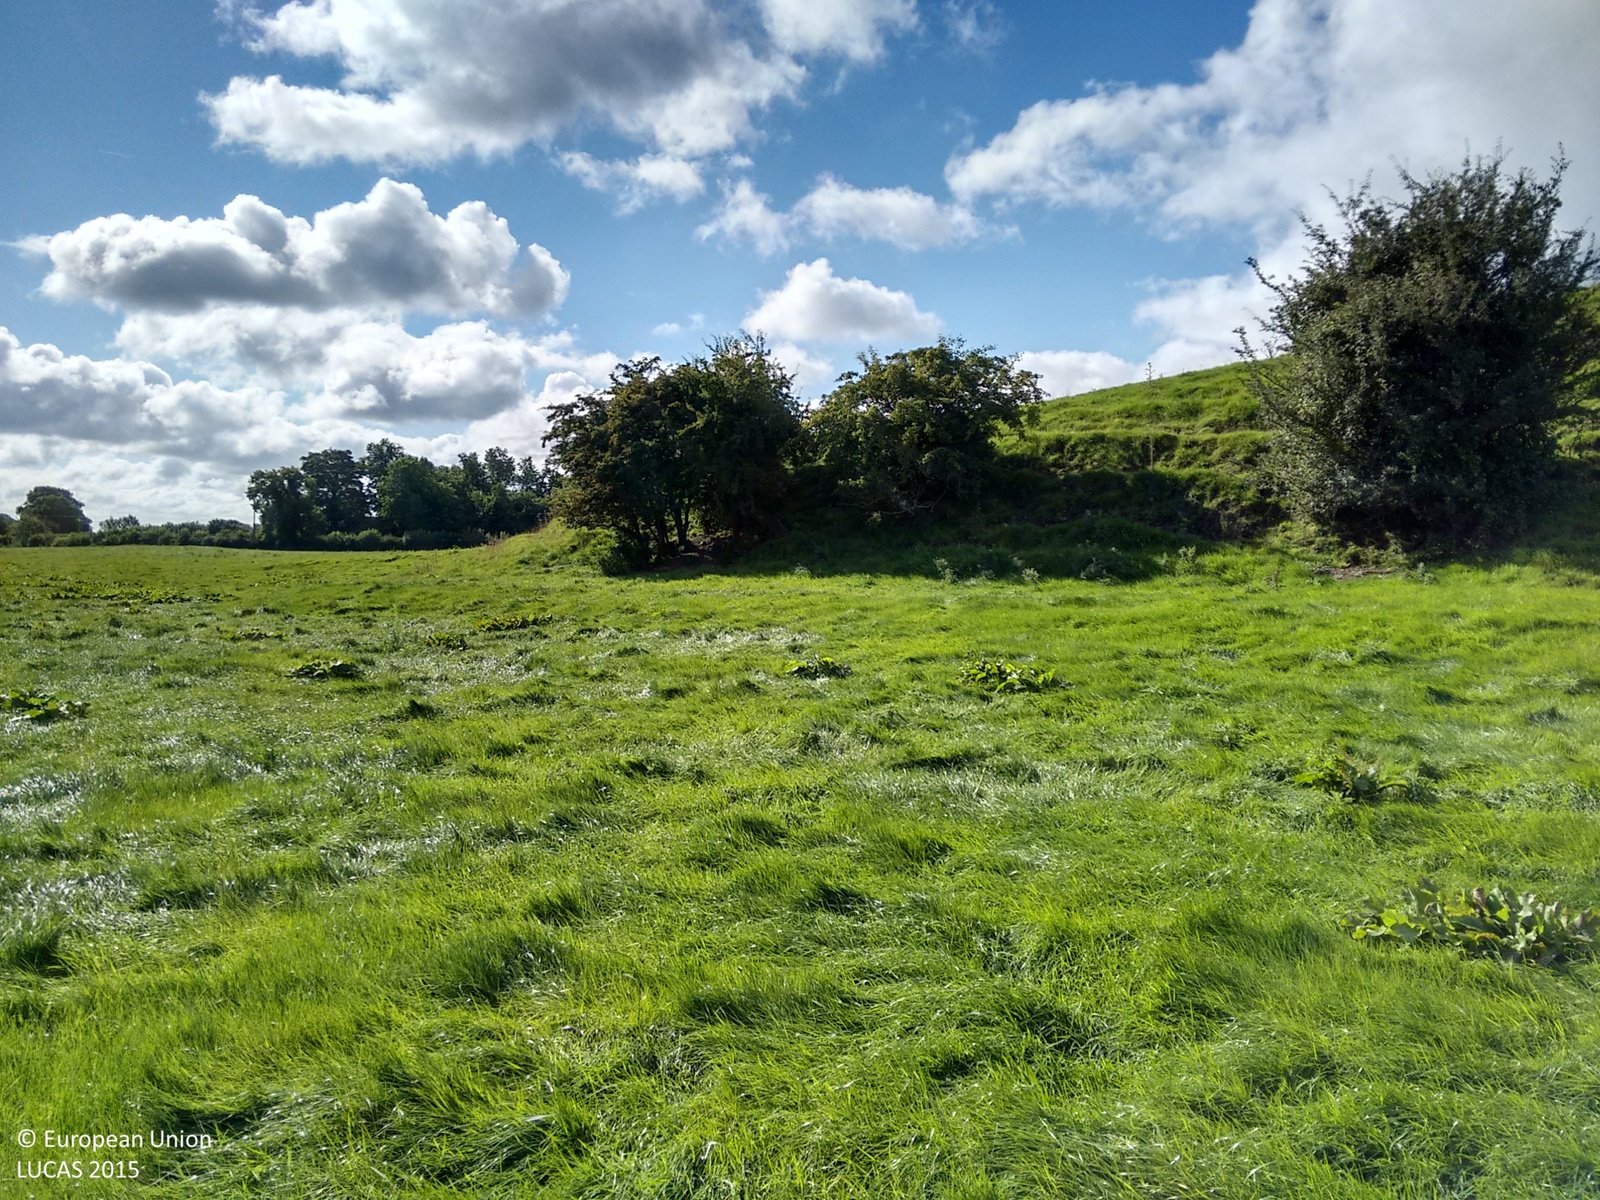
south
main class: Grassland
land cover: Grassland without tree/shrub cover
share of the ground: > 75 %
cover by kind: herbaceous plants 100 %
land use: Agriculture (excluding fallow land and kitchen gardens)
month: September
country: IE
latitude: 53.7010
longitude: -7.0942
